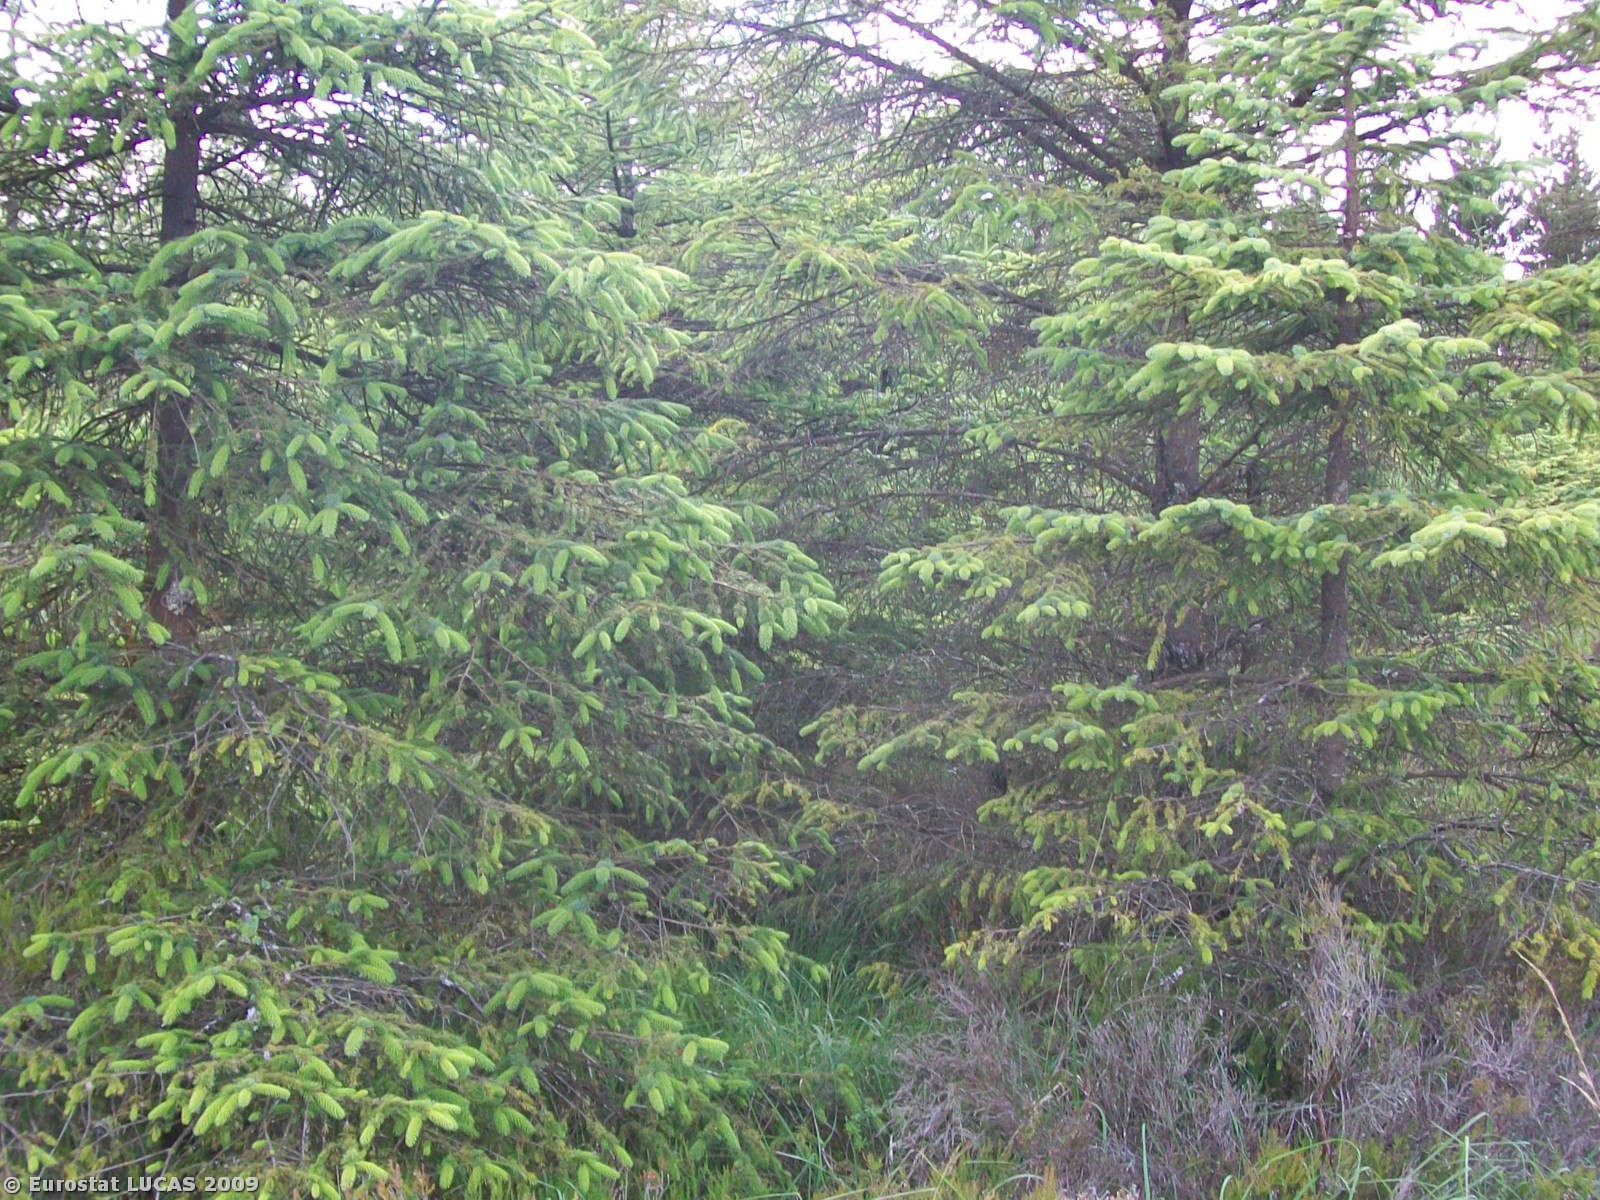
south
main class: Woodland
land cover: Coniferous woodland
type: plantations and self-sown exotic forest
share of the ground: > 75 %
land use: Forestry
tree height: > 5 m
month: July
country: IE
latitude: 54.0942
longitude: -8.9077
